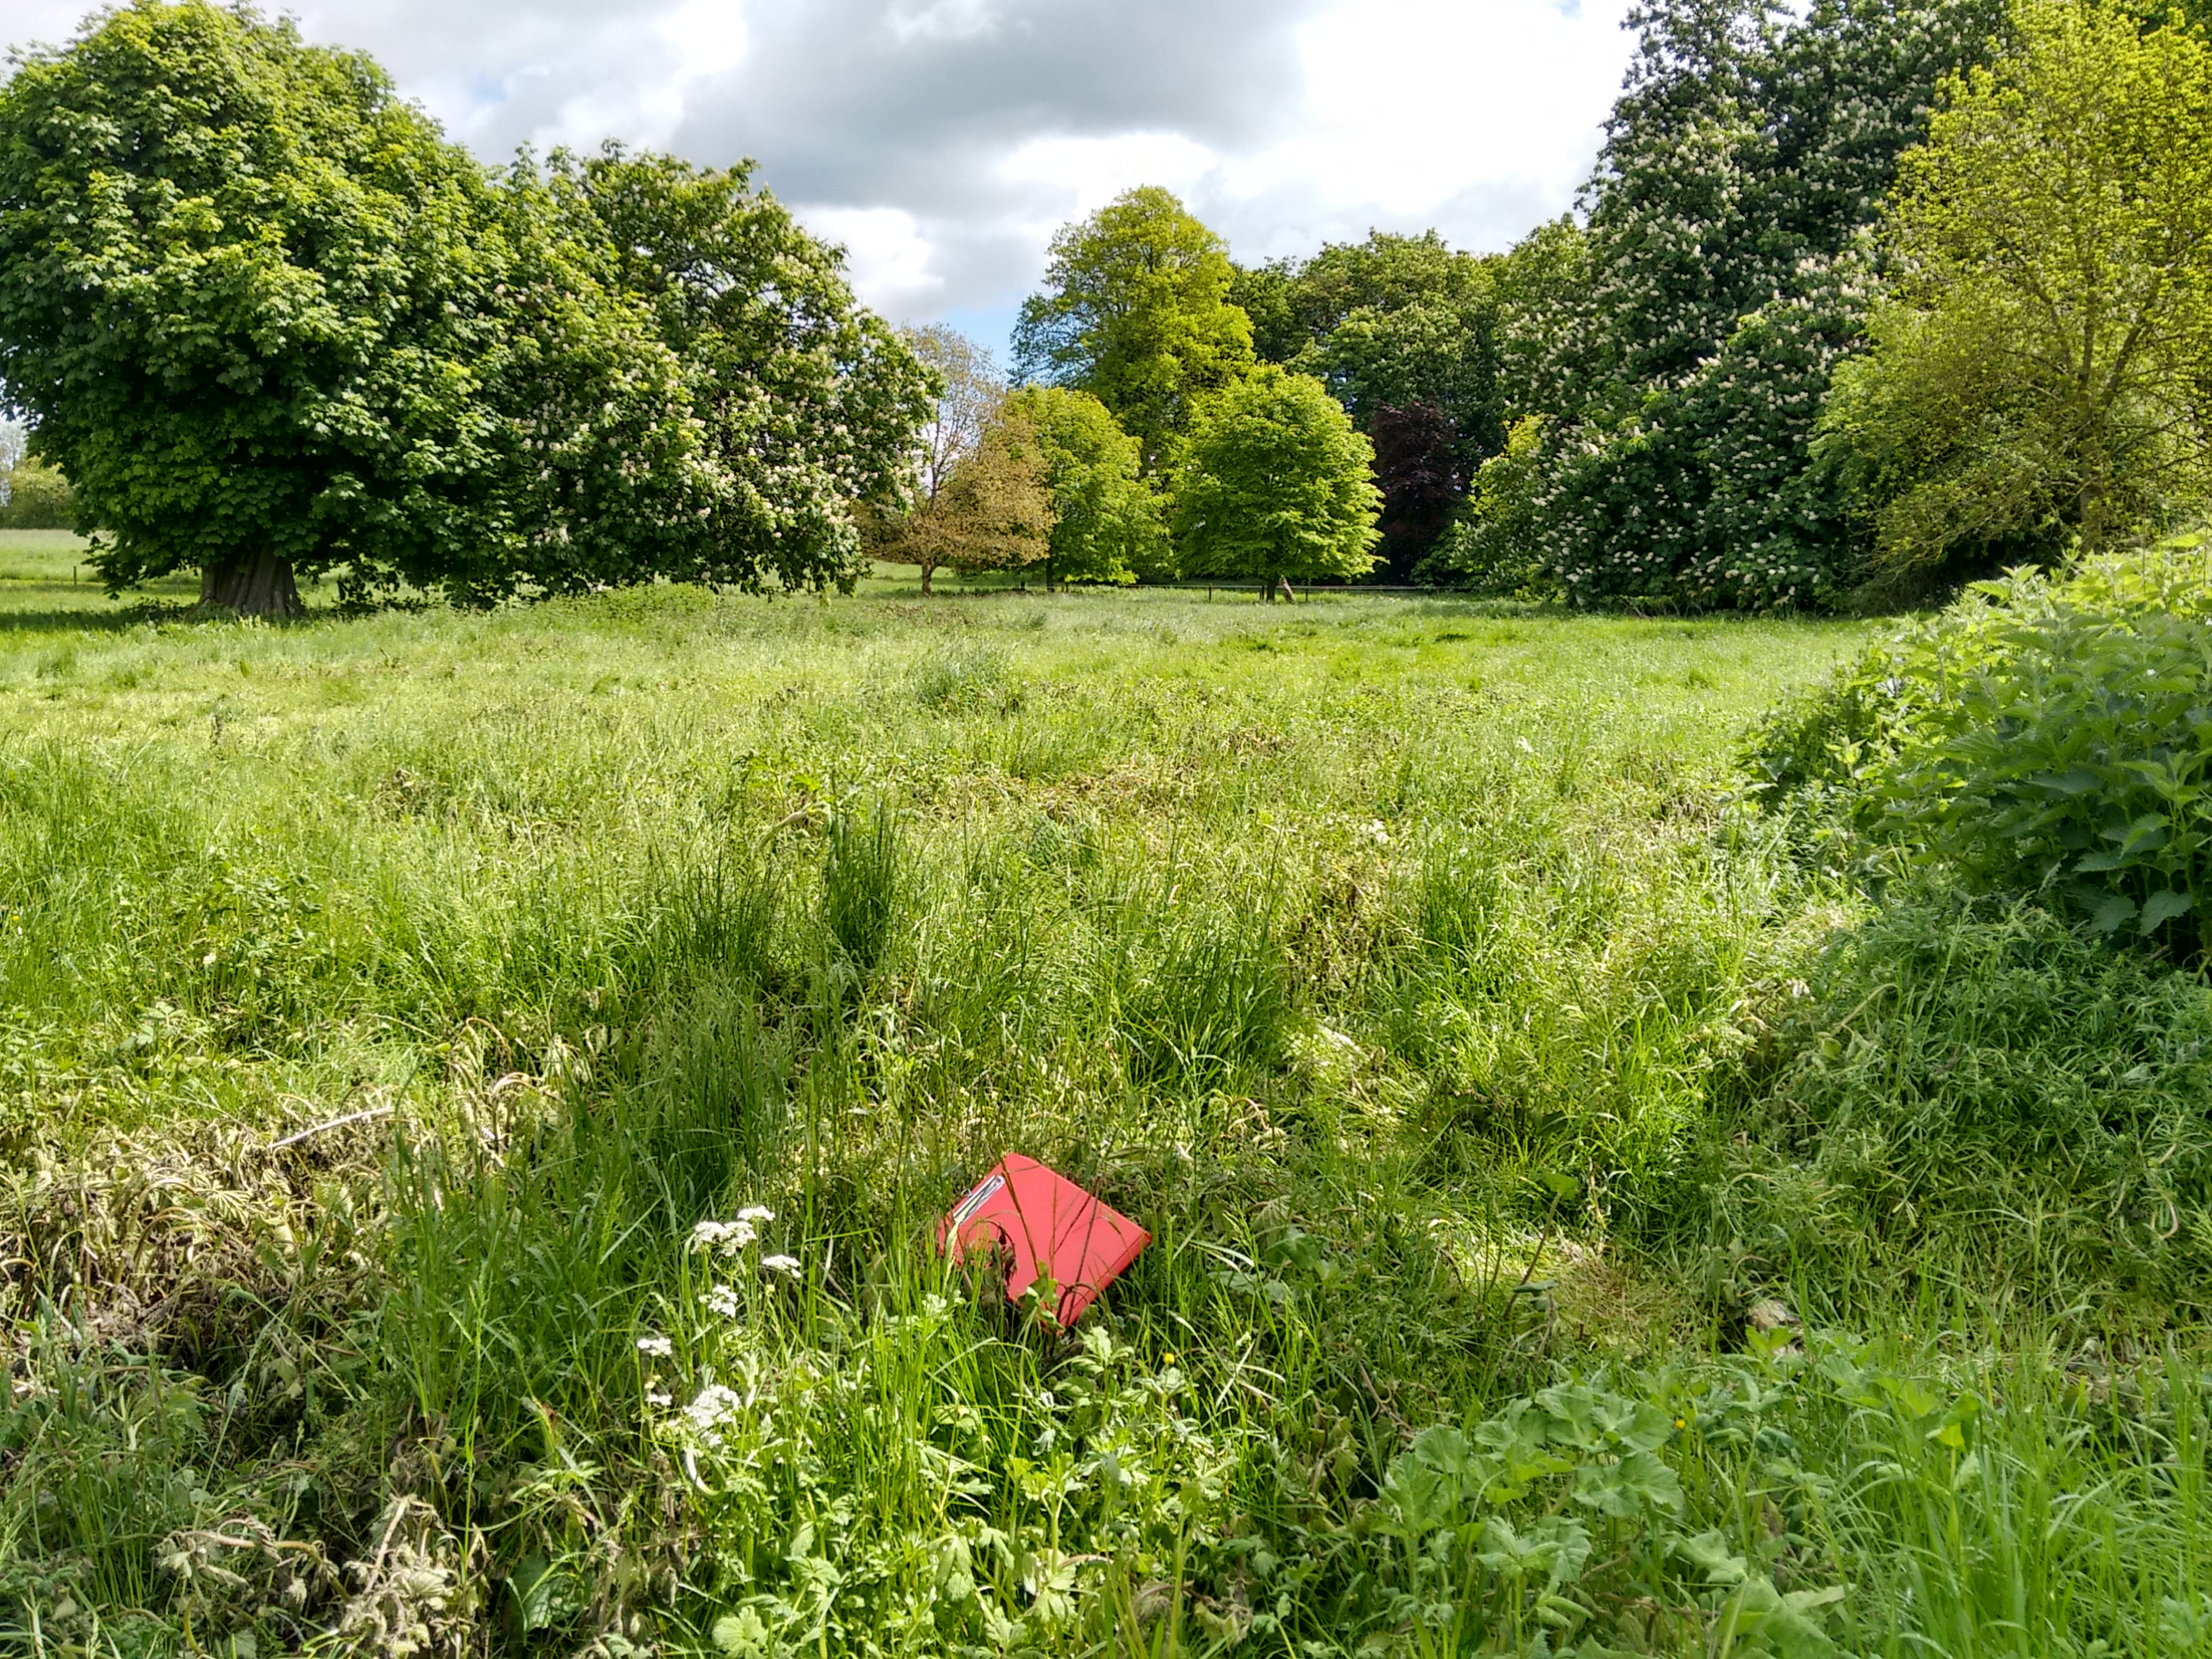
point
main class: Grassland
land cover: Grassland with sparse tree/shrub cover
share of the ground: > 75 %
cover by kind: herbaceous plants 90 %, broadleaved forest trees 5 %, shrubs 5 %
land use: Agriculture (excluding fallow land and kitchen gardens)
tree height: > 5 m
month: May
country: IE
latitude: 53.6125
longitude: -6.8081
